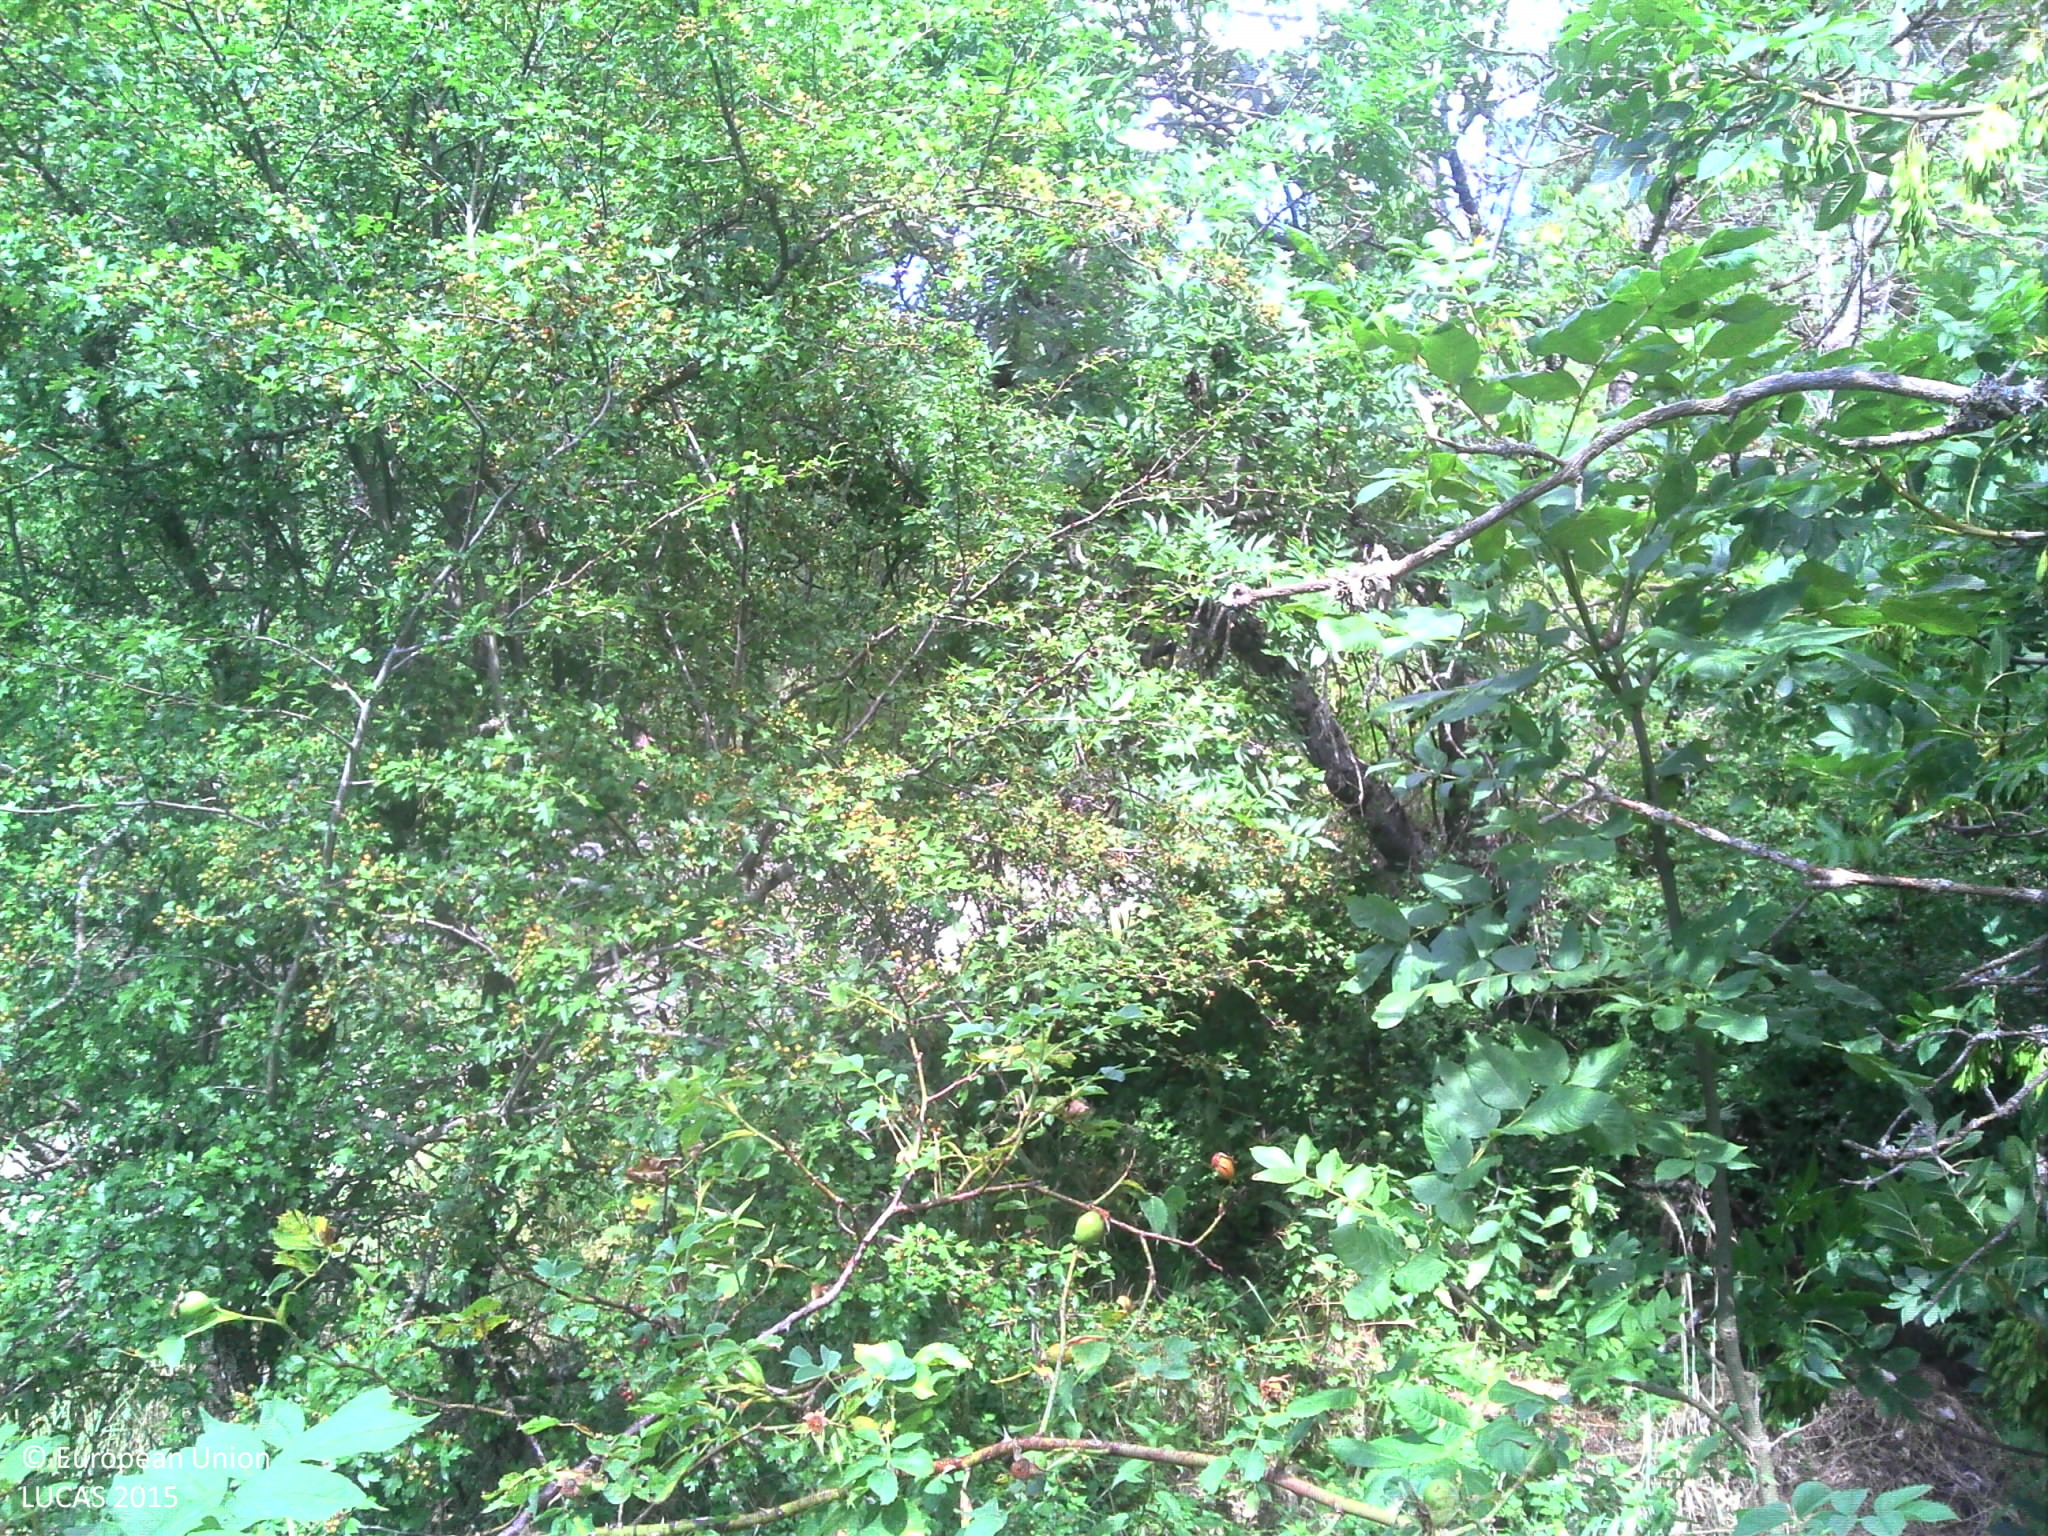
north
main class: Woodland
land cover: Broadleaved woodland
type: thermophilous deciduous forest
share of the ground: > 75 %
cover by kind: broadleaved forest trees 60 %, herbaceous plants 25 %, unconsolidated bare surface 15 %
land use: Forestry
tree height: > 5 m
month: August
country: FR
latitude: 44.3597
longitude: 6.3807
